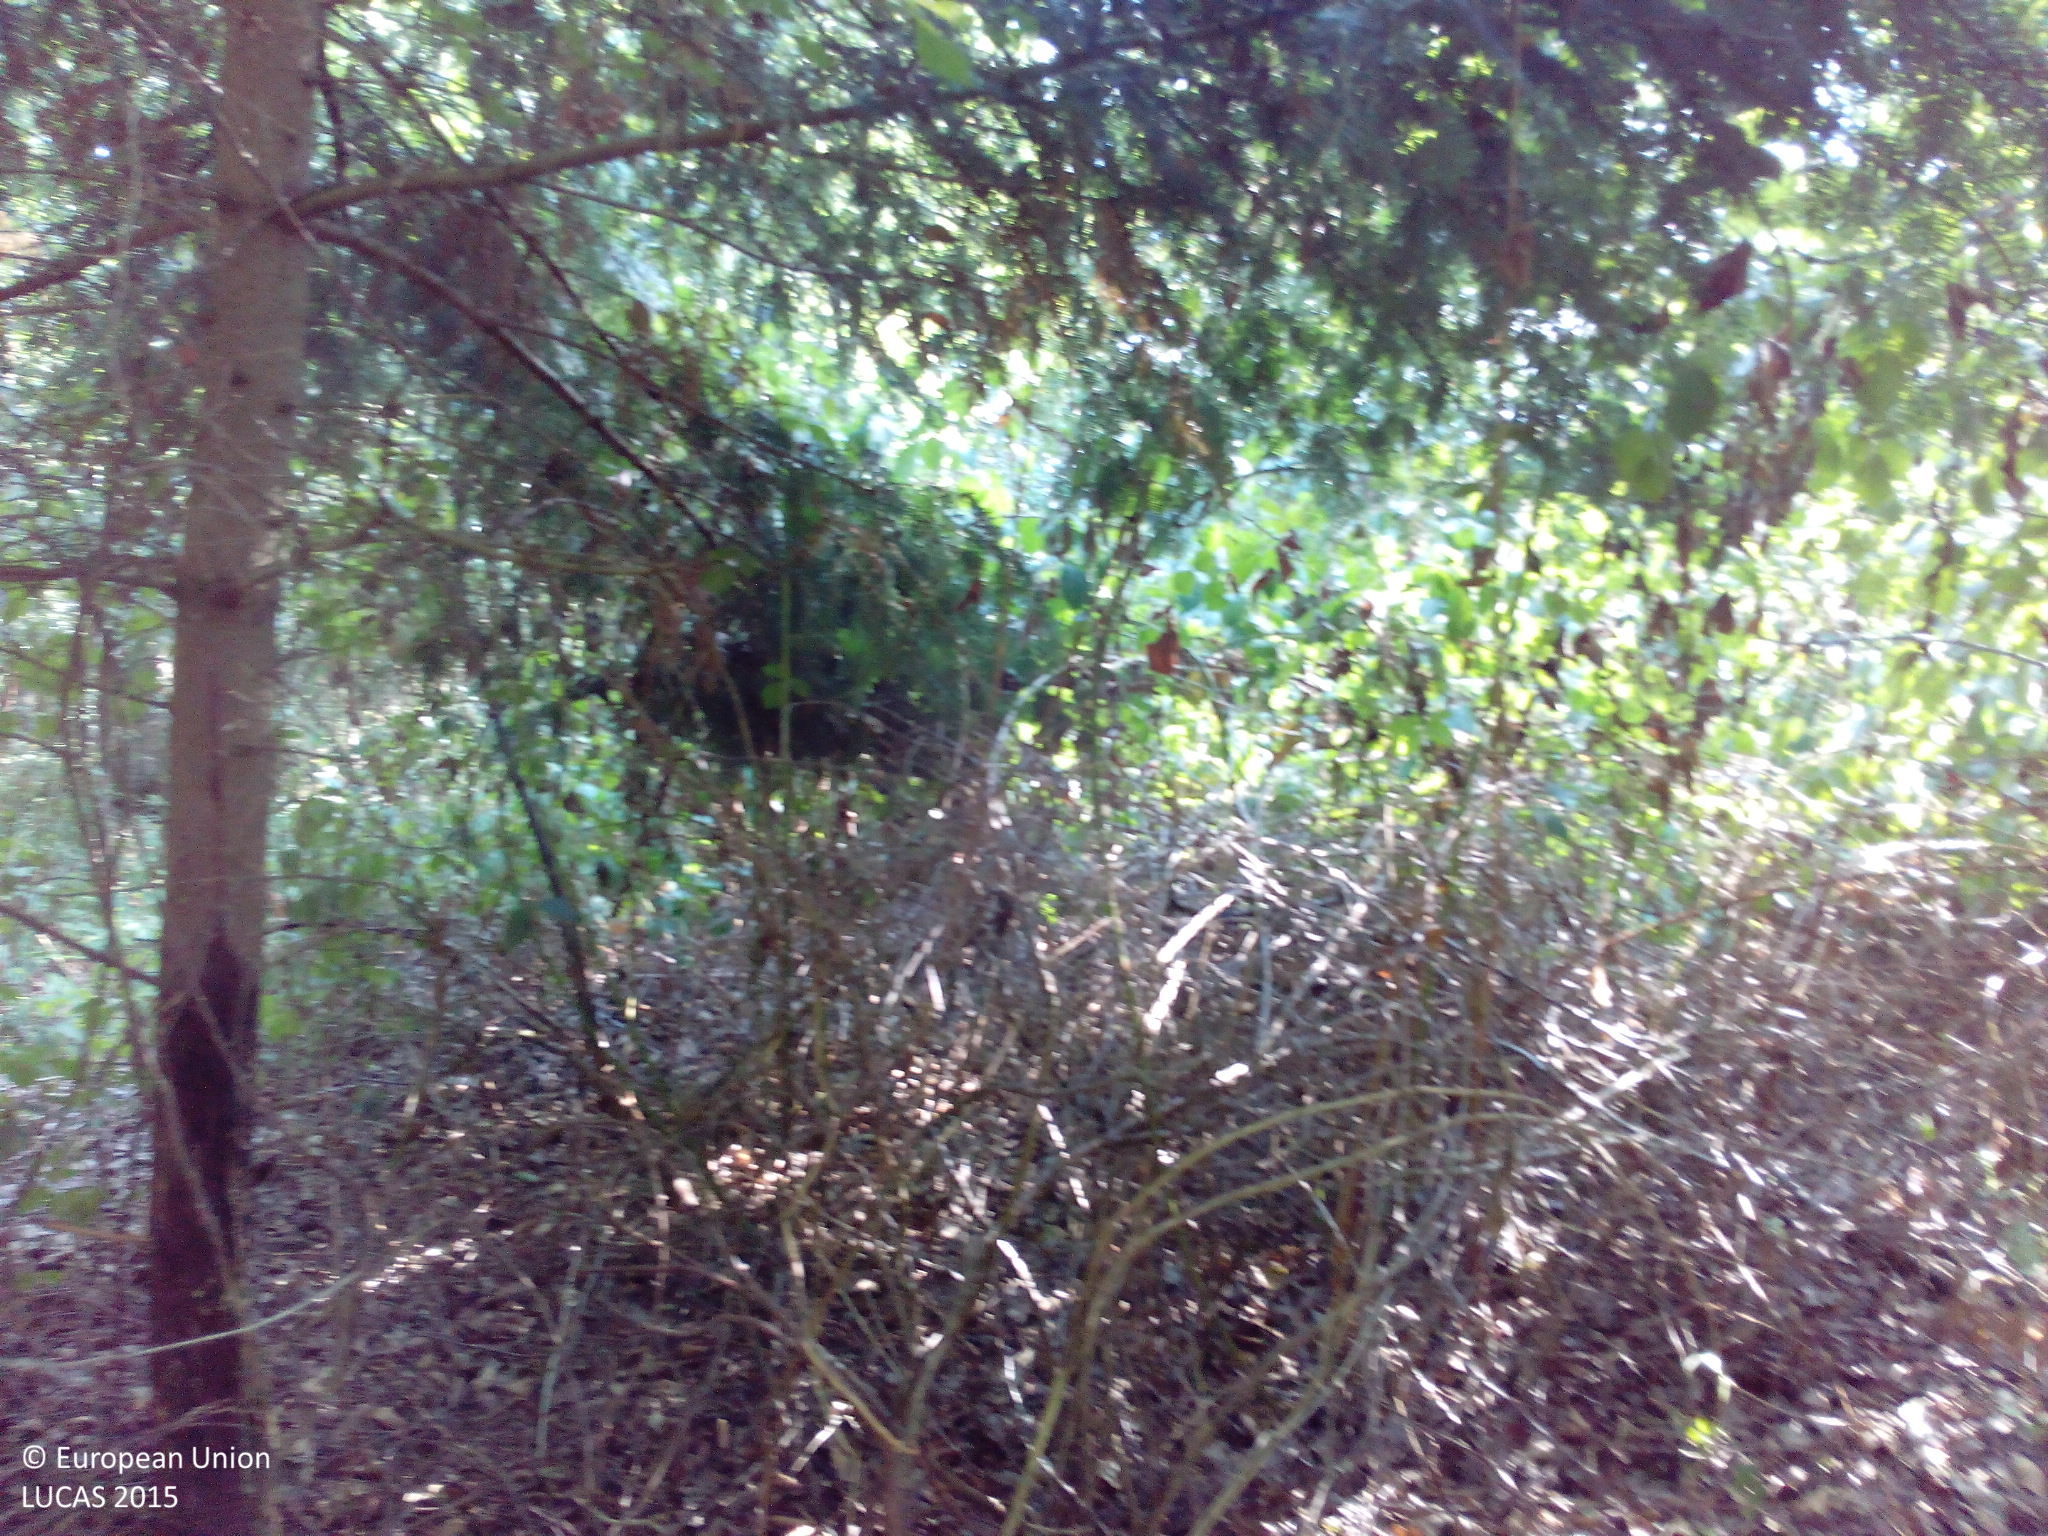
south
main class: Woodland
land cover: Broadleaved woodland
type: mesophytic deciduous forest
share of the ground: > 75 %
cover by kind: broadleaved forest trees 75 %, shrubs 10 %, unconsolidated bare surface 10 %, coniferous forest trees 5 %
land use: Forestry
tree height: > 5 m
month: August
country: DE
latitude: 50.1741
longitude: 7.4659
